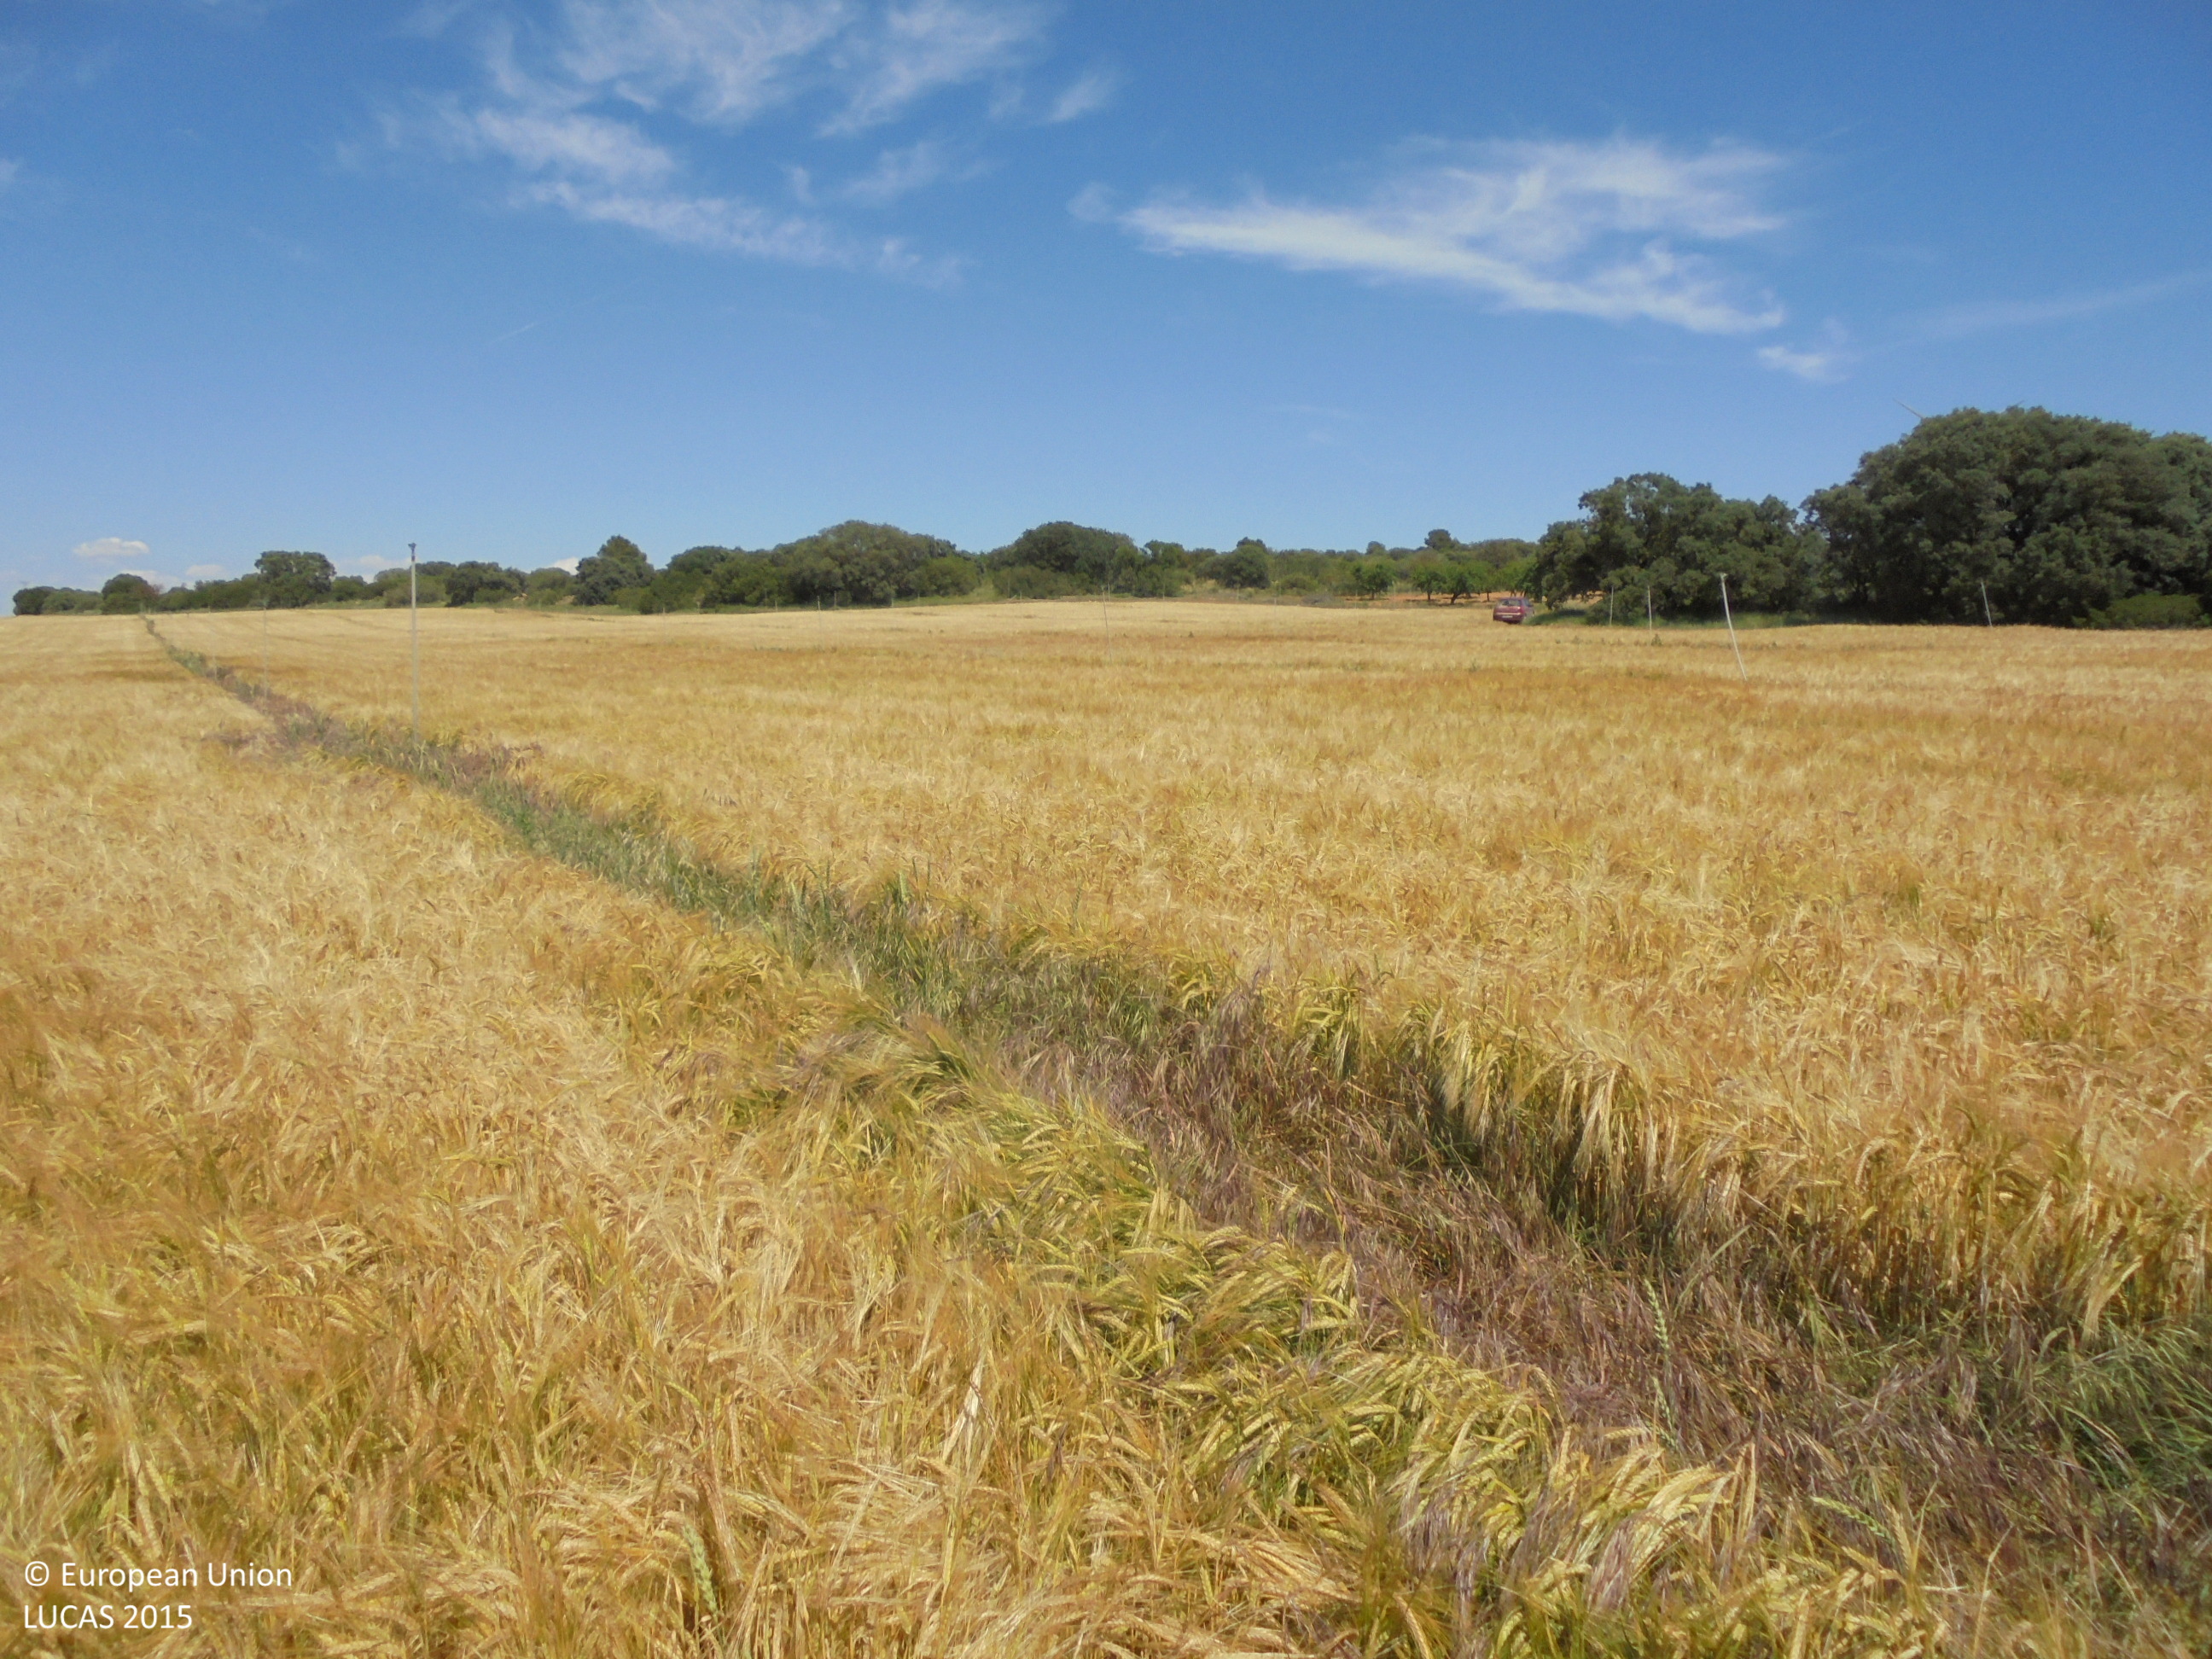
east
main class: Cropland
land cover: Barley
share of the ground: > 75 %
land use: Agriculture (excluding fallow land and kitchen gardens)
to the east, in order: Barley; Grass margins; Tracks; Grass margins; Fences; Broadleaved woodland; Tracks; Dry stone walls; Broadleaved woodland; Nuts trees
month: June
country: ES
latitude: 38.7593
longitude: -1.5609
